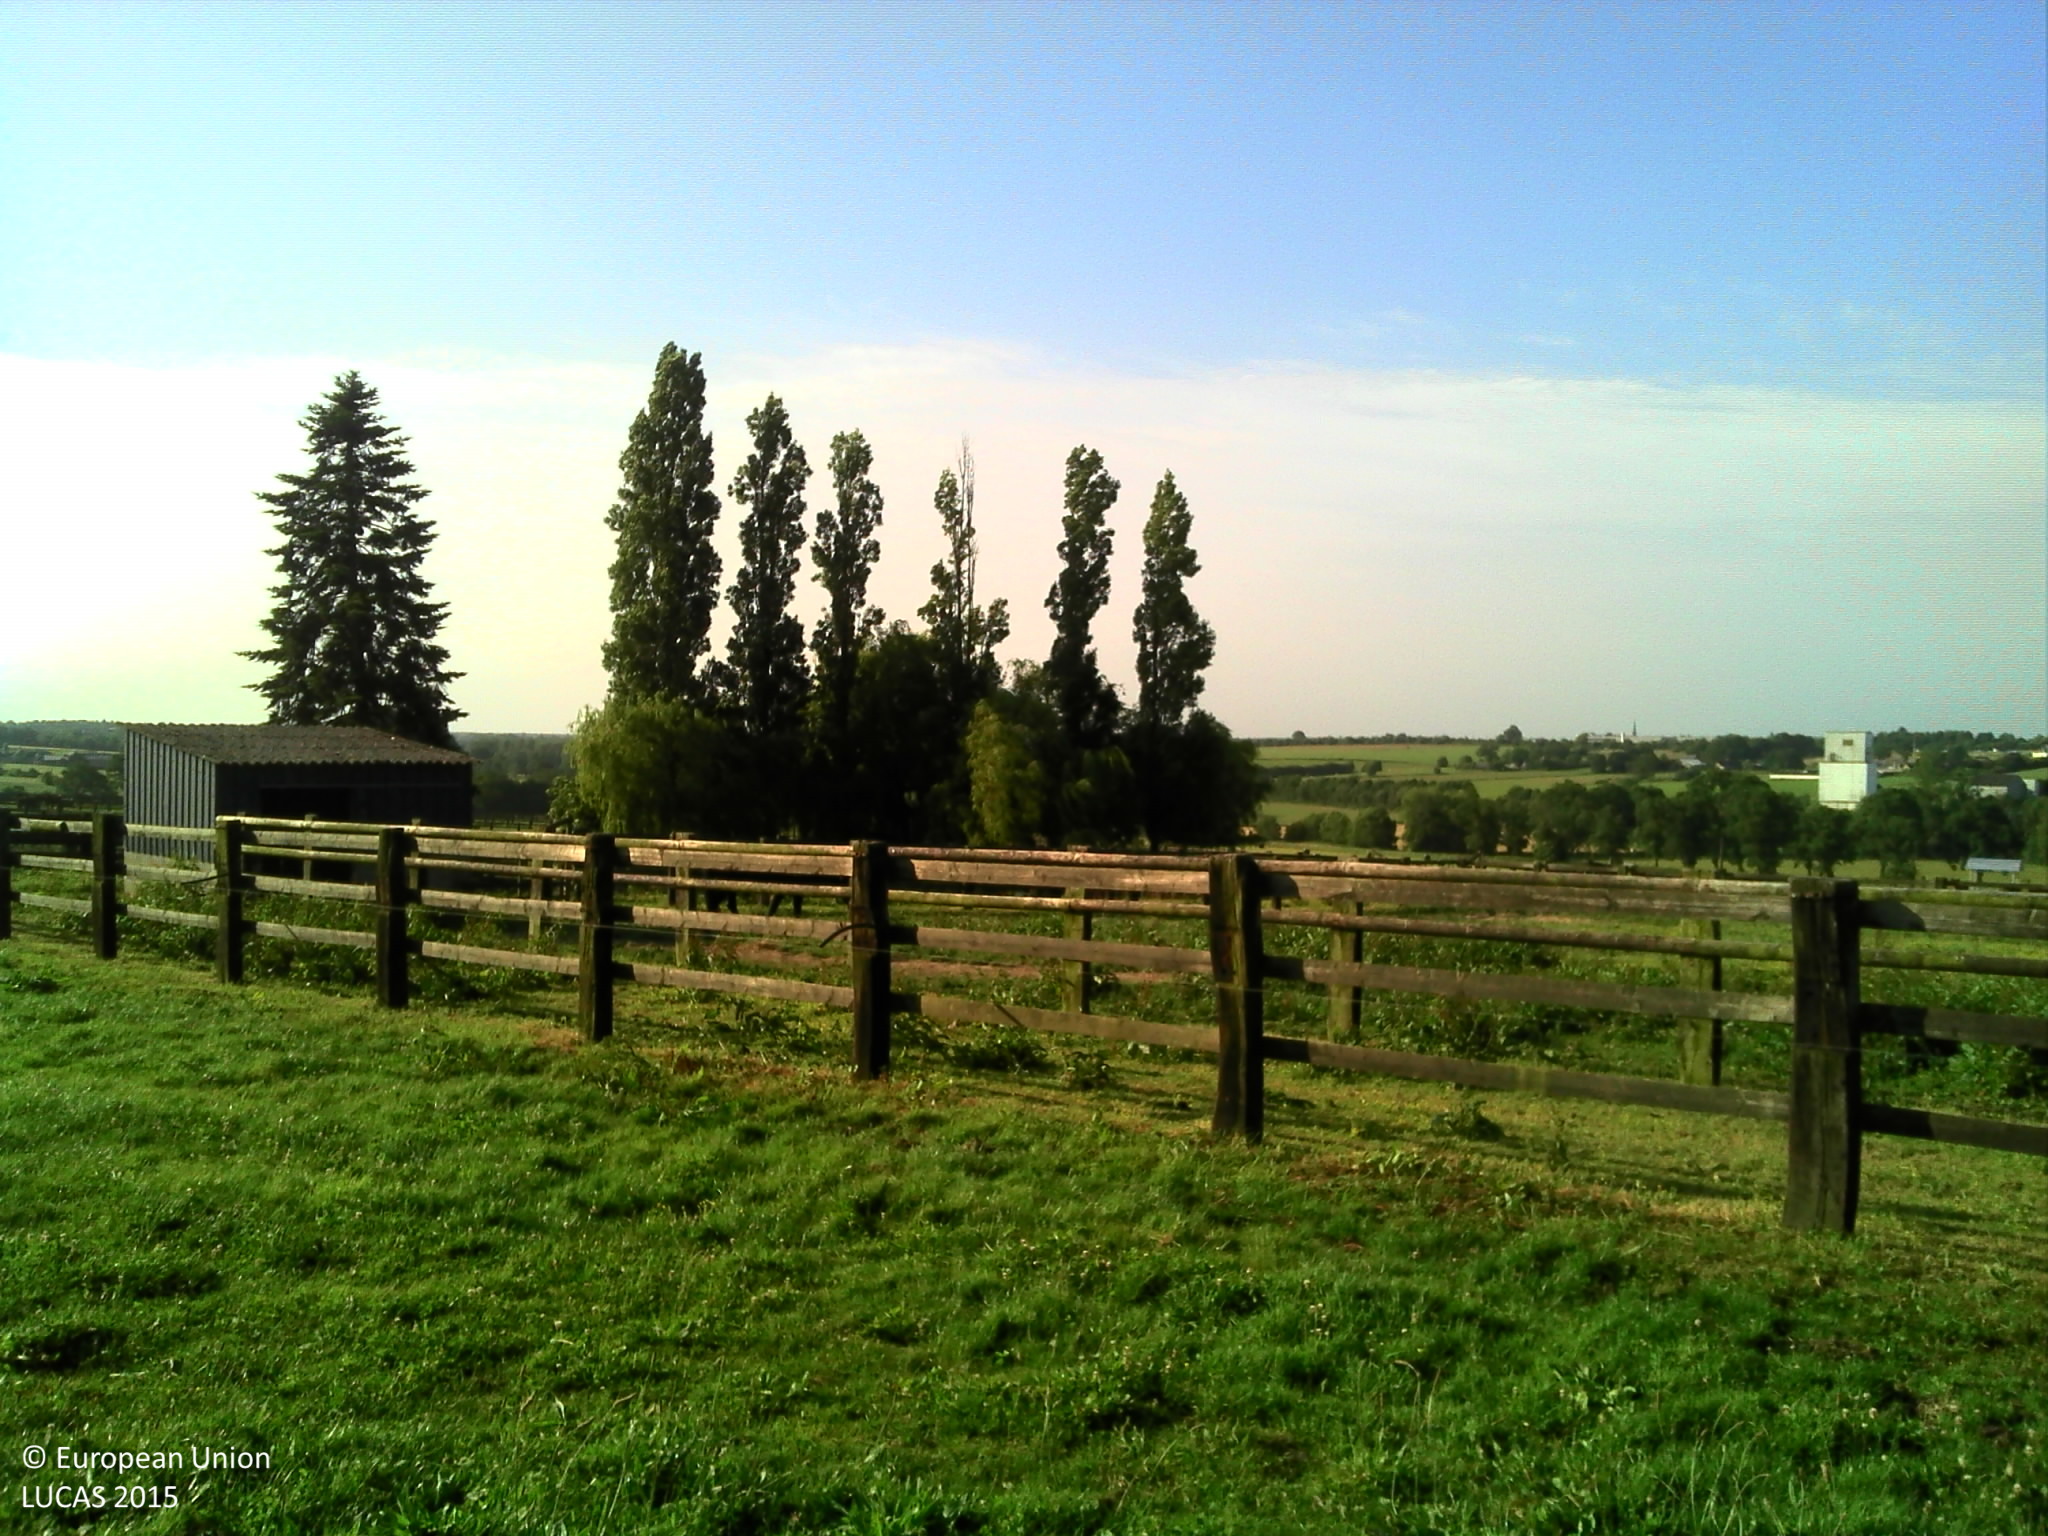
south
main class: Grassland
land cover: Grassland without tree/shrub cover
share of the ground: > 75 %
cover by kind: herbaceous plants 100 %
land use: Sport
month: June
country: FR
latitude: 48.0870
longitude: -1.1979
